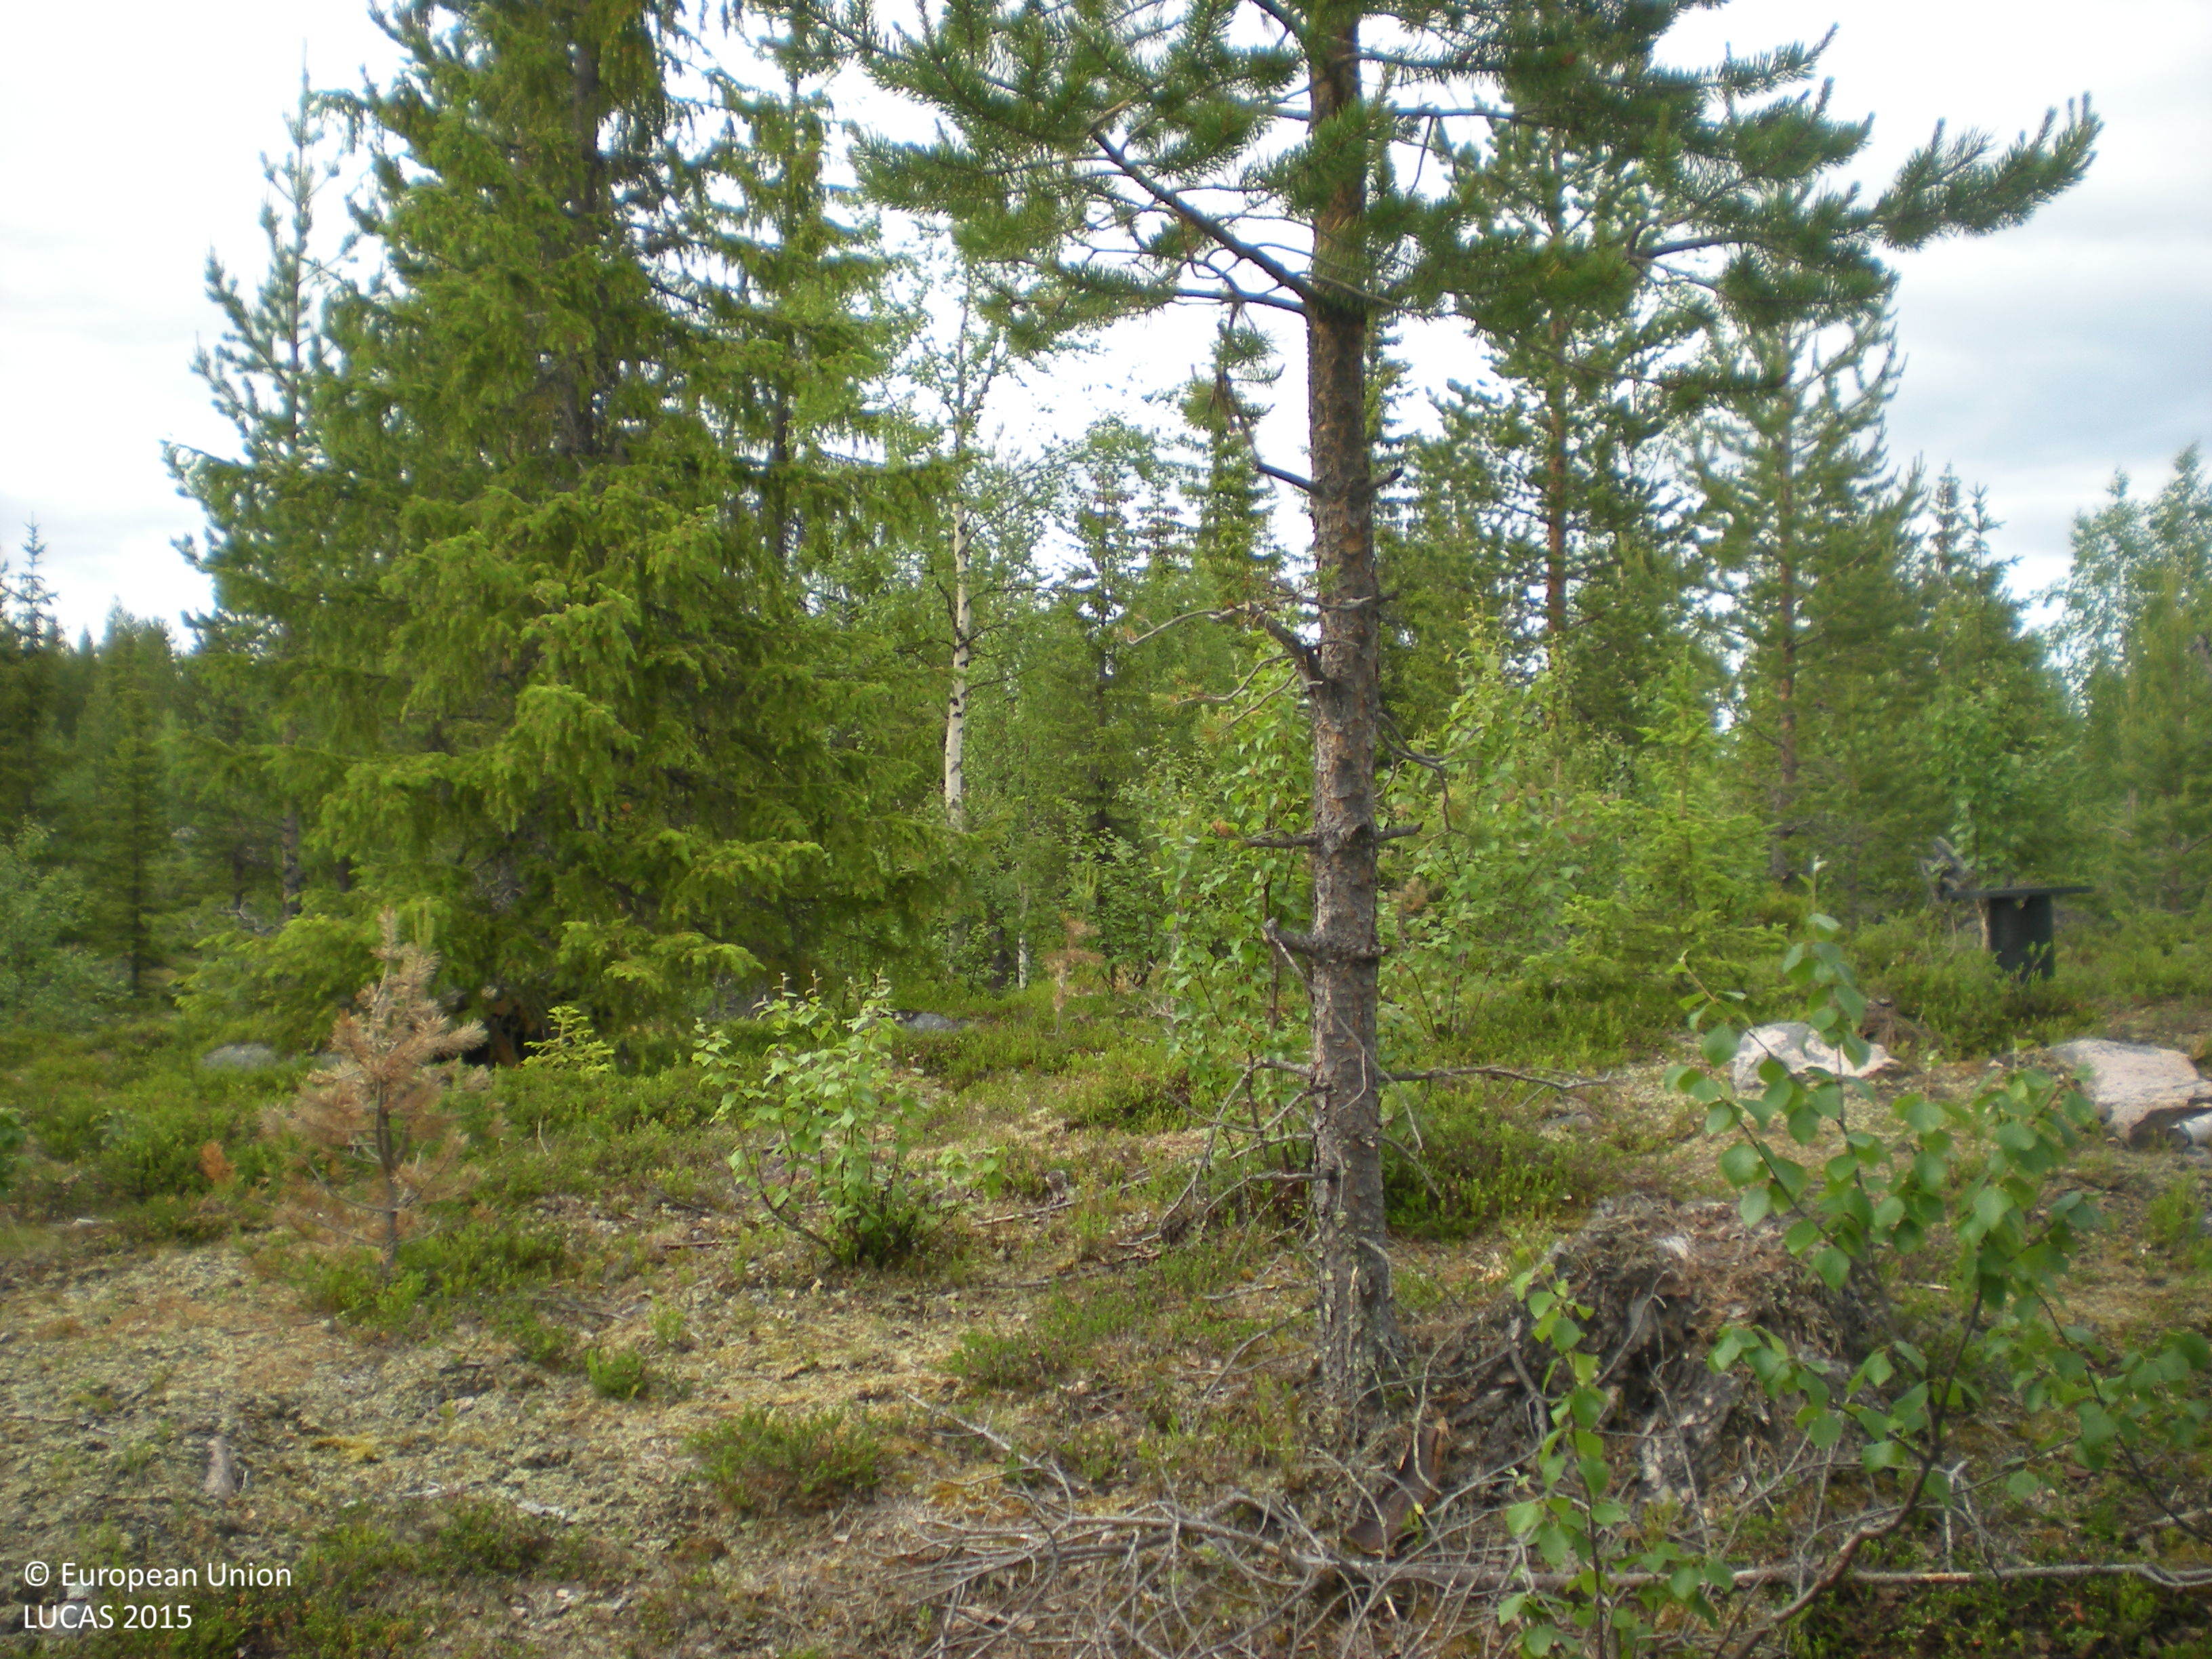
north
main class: Woodland
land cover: Other mixed woodland
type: boreal forest
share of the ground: 50 - 75 %
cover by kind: coniferous forest trees 40 %, shrubs 30 %, broadleaved forest trees 15 %, lichens and mosses 10 %, consolidated bare surface 5 %
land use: Forestry
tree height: > 5 m
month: July
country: SE
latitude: 65.6563
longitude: 17.0686
